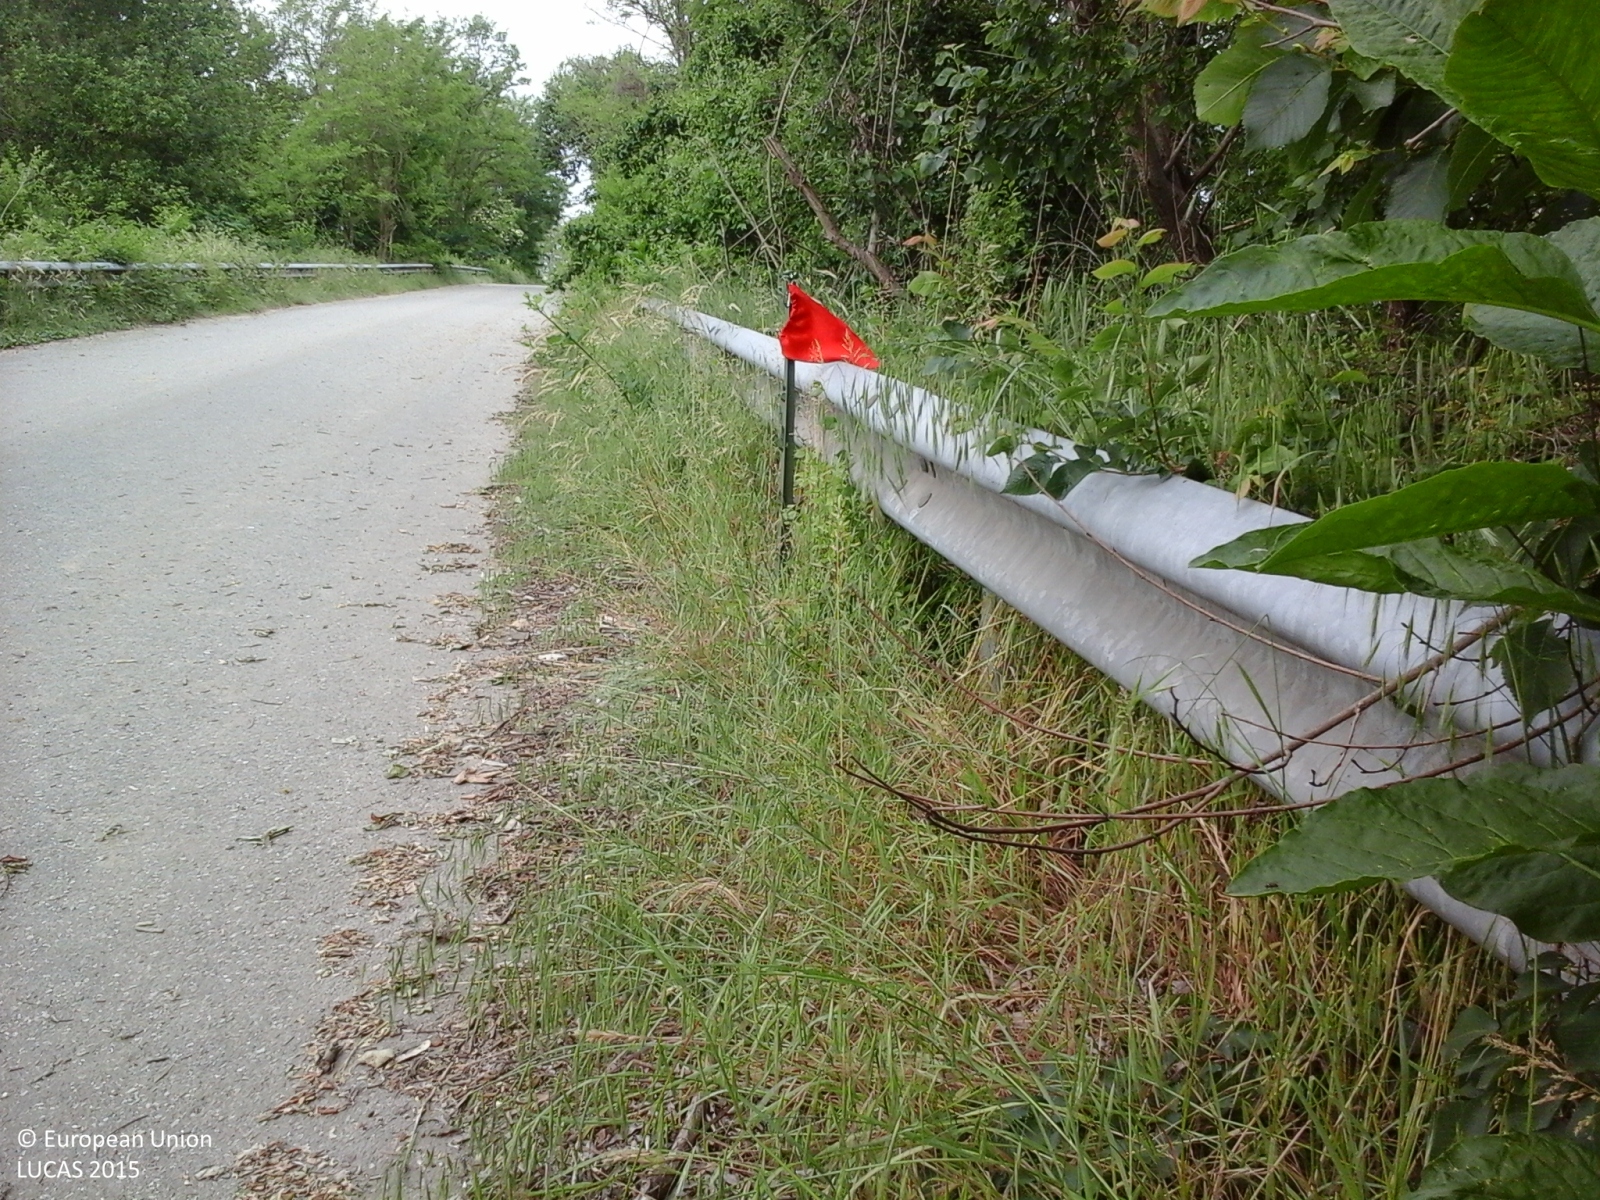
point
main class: Woodland
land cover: Broadleaved woodland
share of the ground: > 75 %
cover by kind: broadleaved forest trees 100 %
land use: Forestry
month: May
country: IT
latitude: 45.5468
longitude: 8.4271
